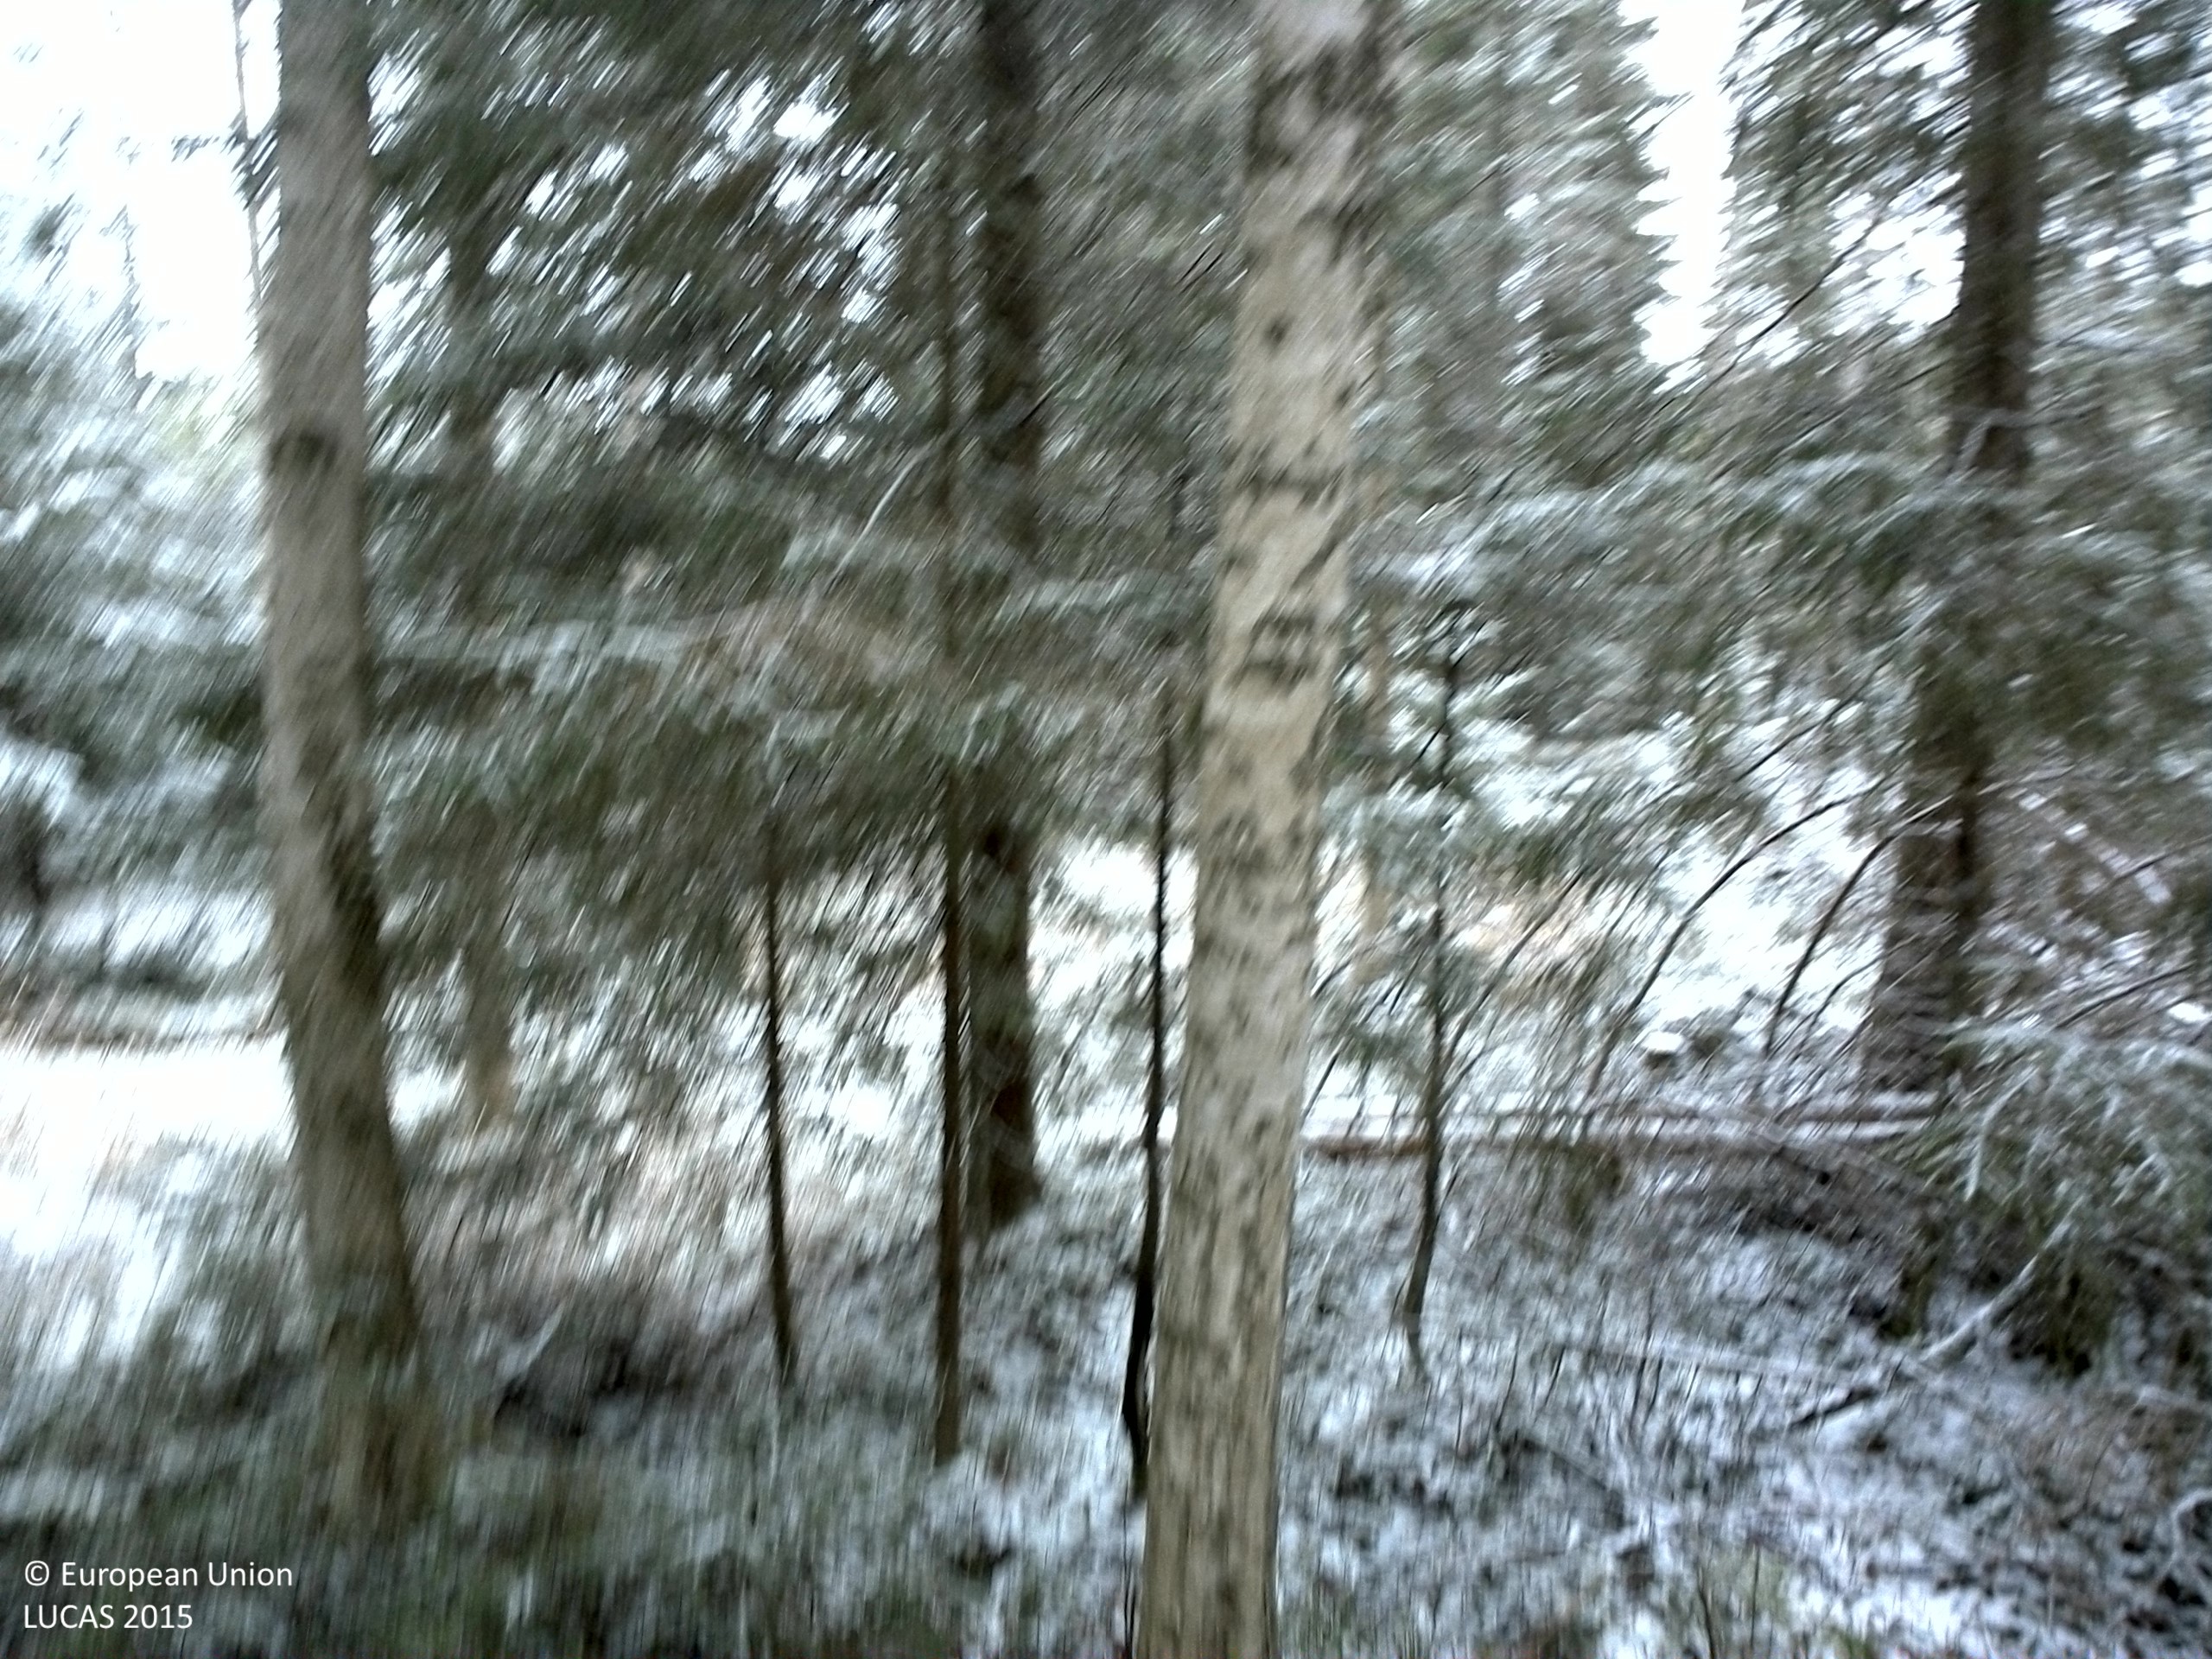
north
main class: Woodland
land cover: Spruce dominated mixed woodland
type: boreal forest
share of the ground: 50 - 75 %
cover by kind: coniferous forest trees 50 %, shrubs 25 %, broadleaved forest trees 20 %, herbaceous plants 5 %
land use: Forestry
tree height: > 5 m
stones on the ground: < 10 %
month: November
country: SE
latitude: 59.9642
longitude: 15.5240
